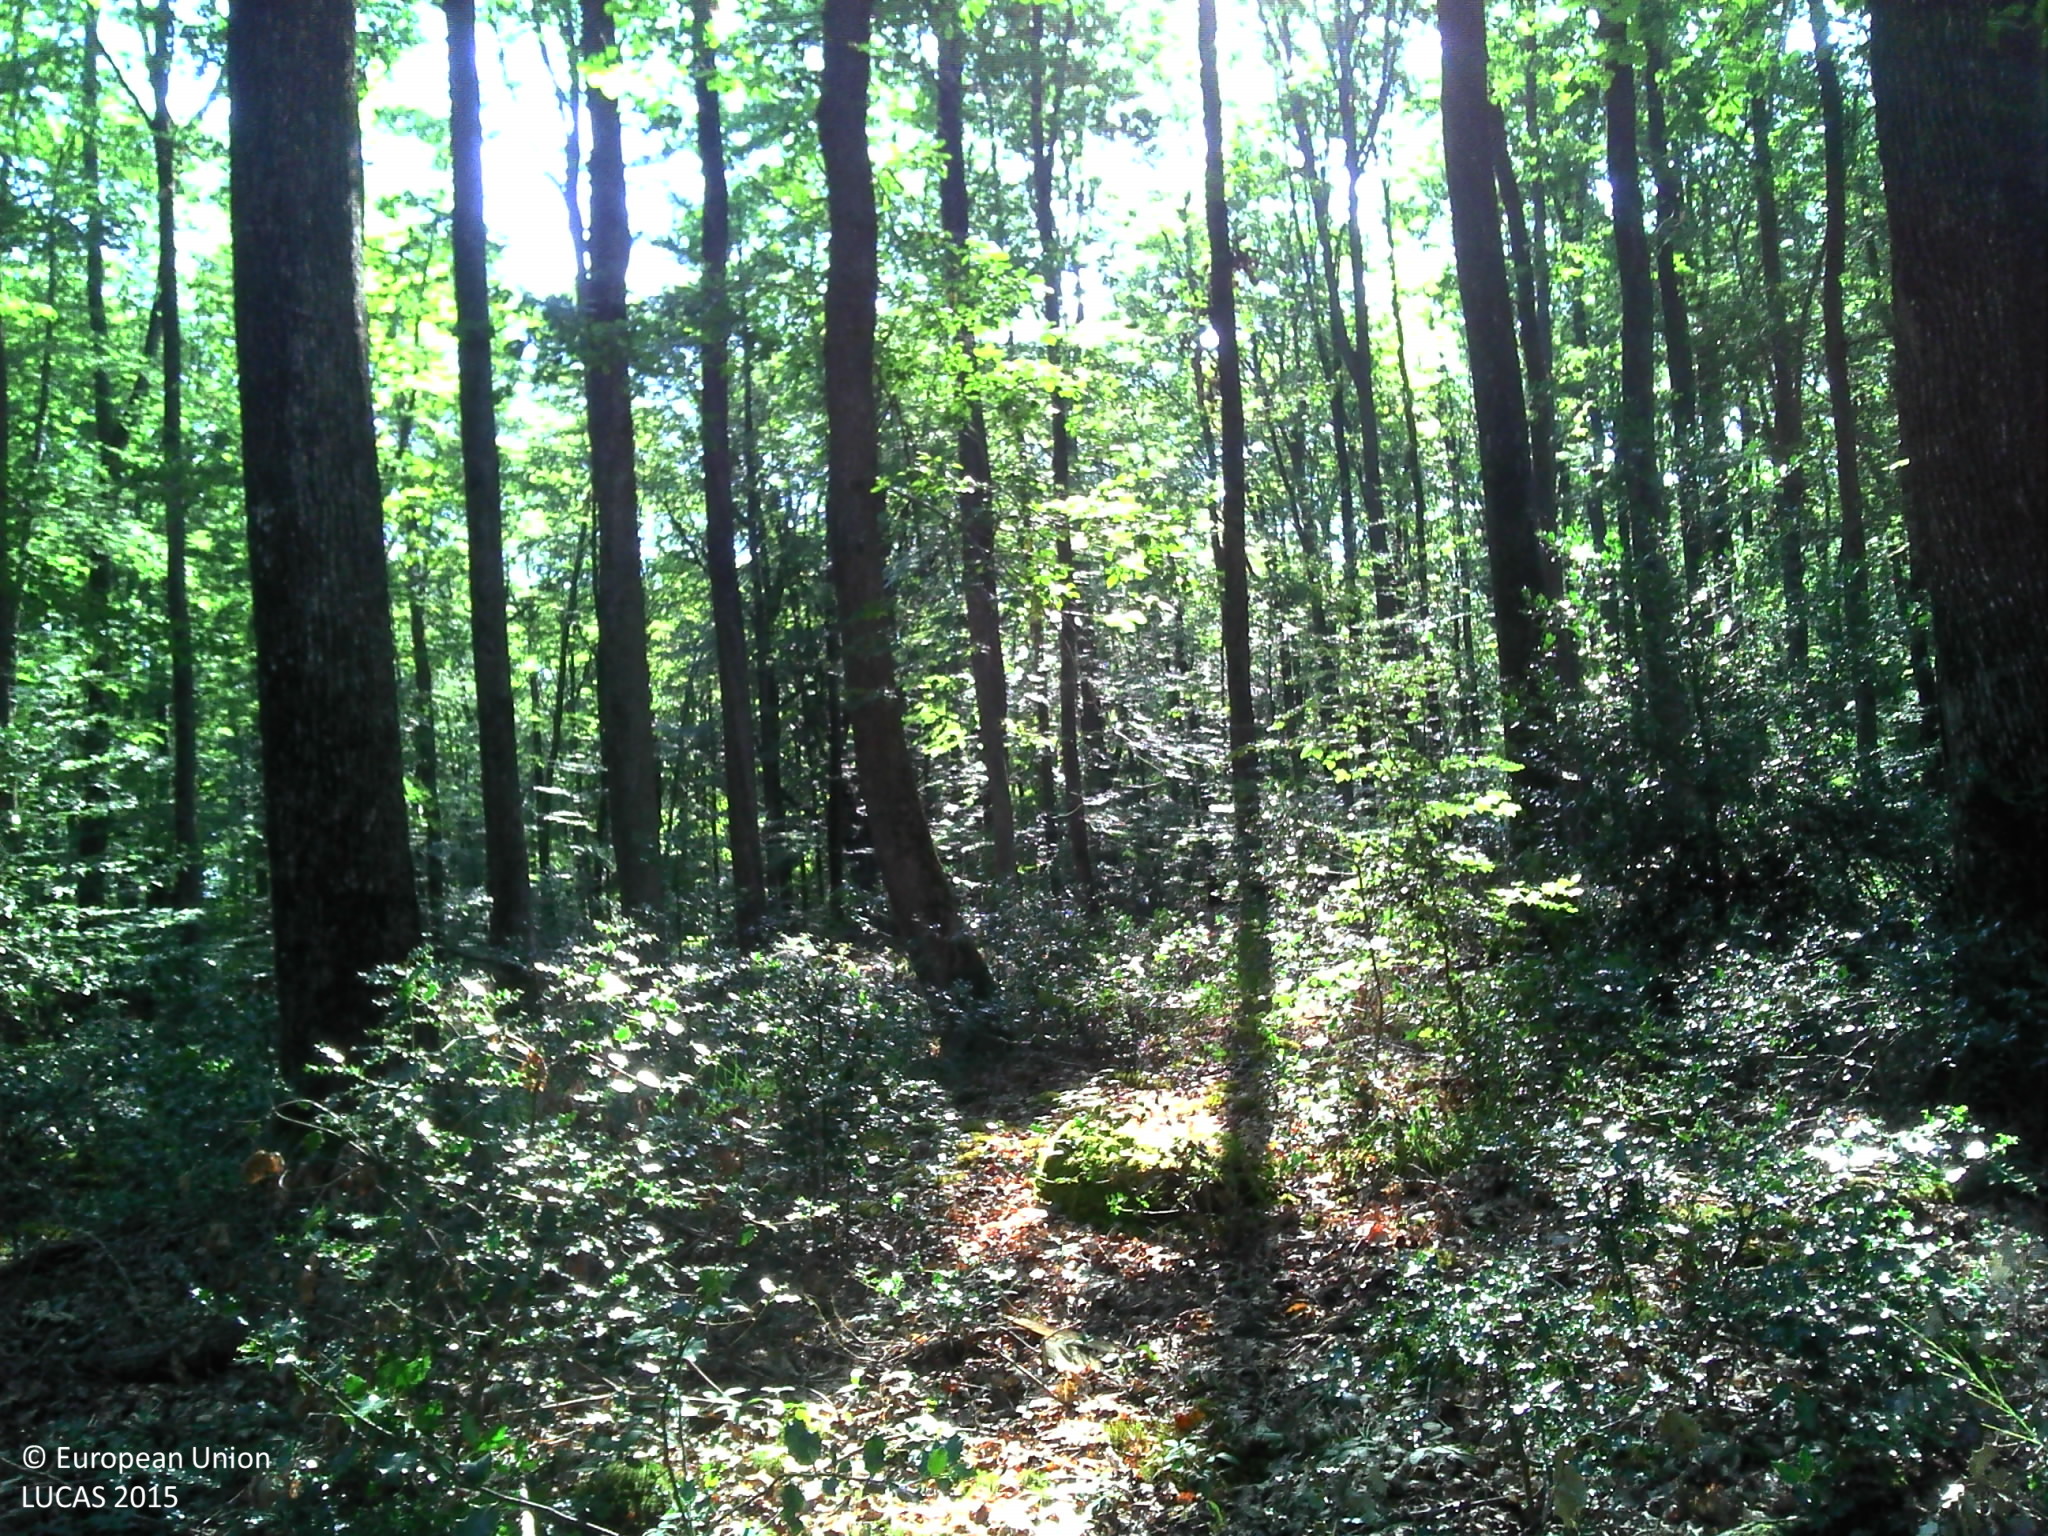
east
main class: Woodland
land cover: Broadleaved woodland
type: mesophytic deciduous forest
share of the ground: > 75 %
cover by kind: broadleaved forest trees 90 %, shrubs 5 %, herbaceous plants 5 %
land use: Forestry
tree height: > 5 m
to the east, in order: Broadleaved woodland; Tracks; Broadleaved woodland
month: August
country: FR
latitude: 46.6523
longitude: 2.8223
